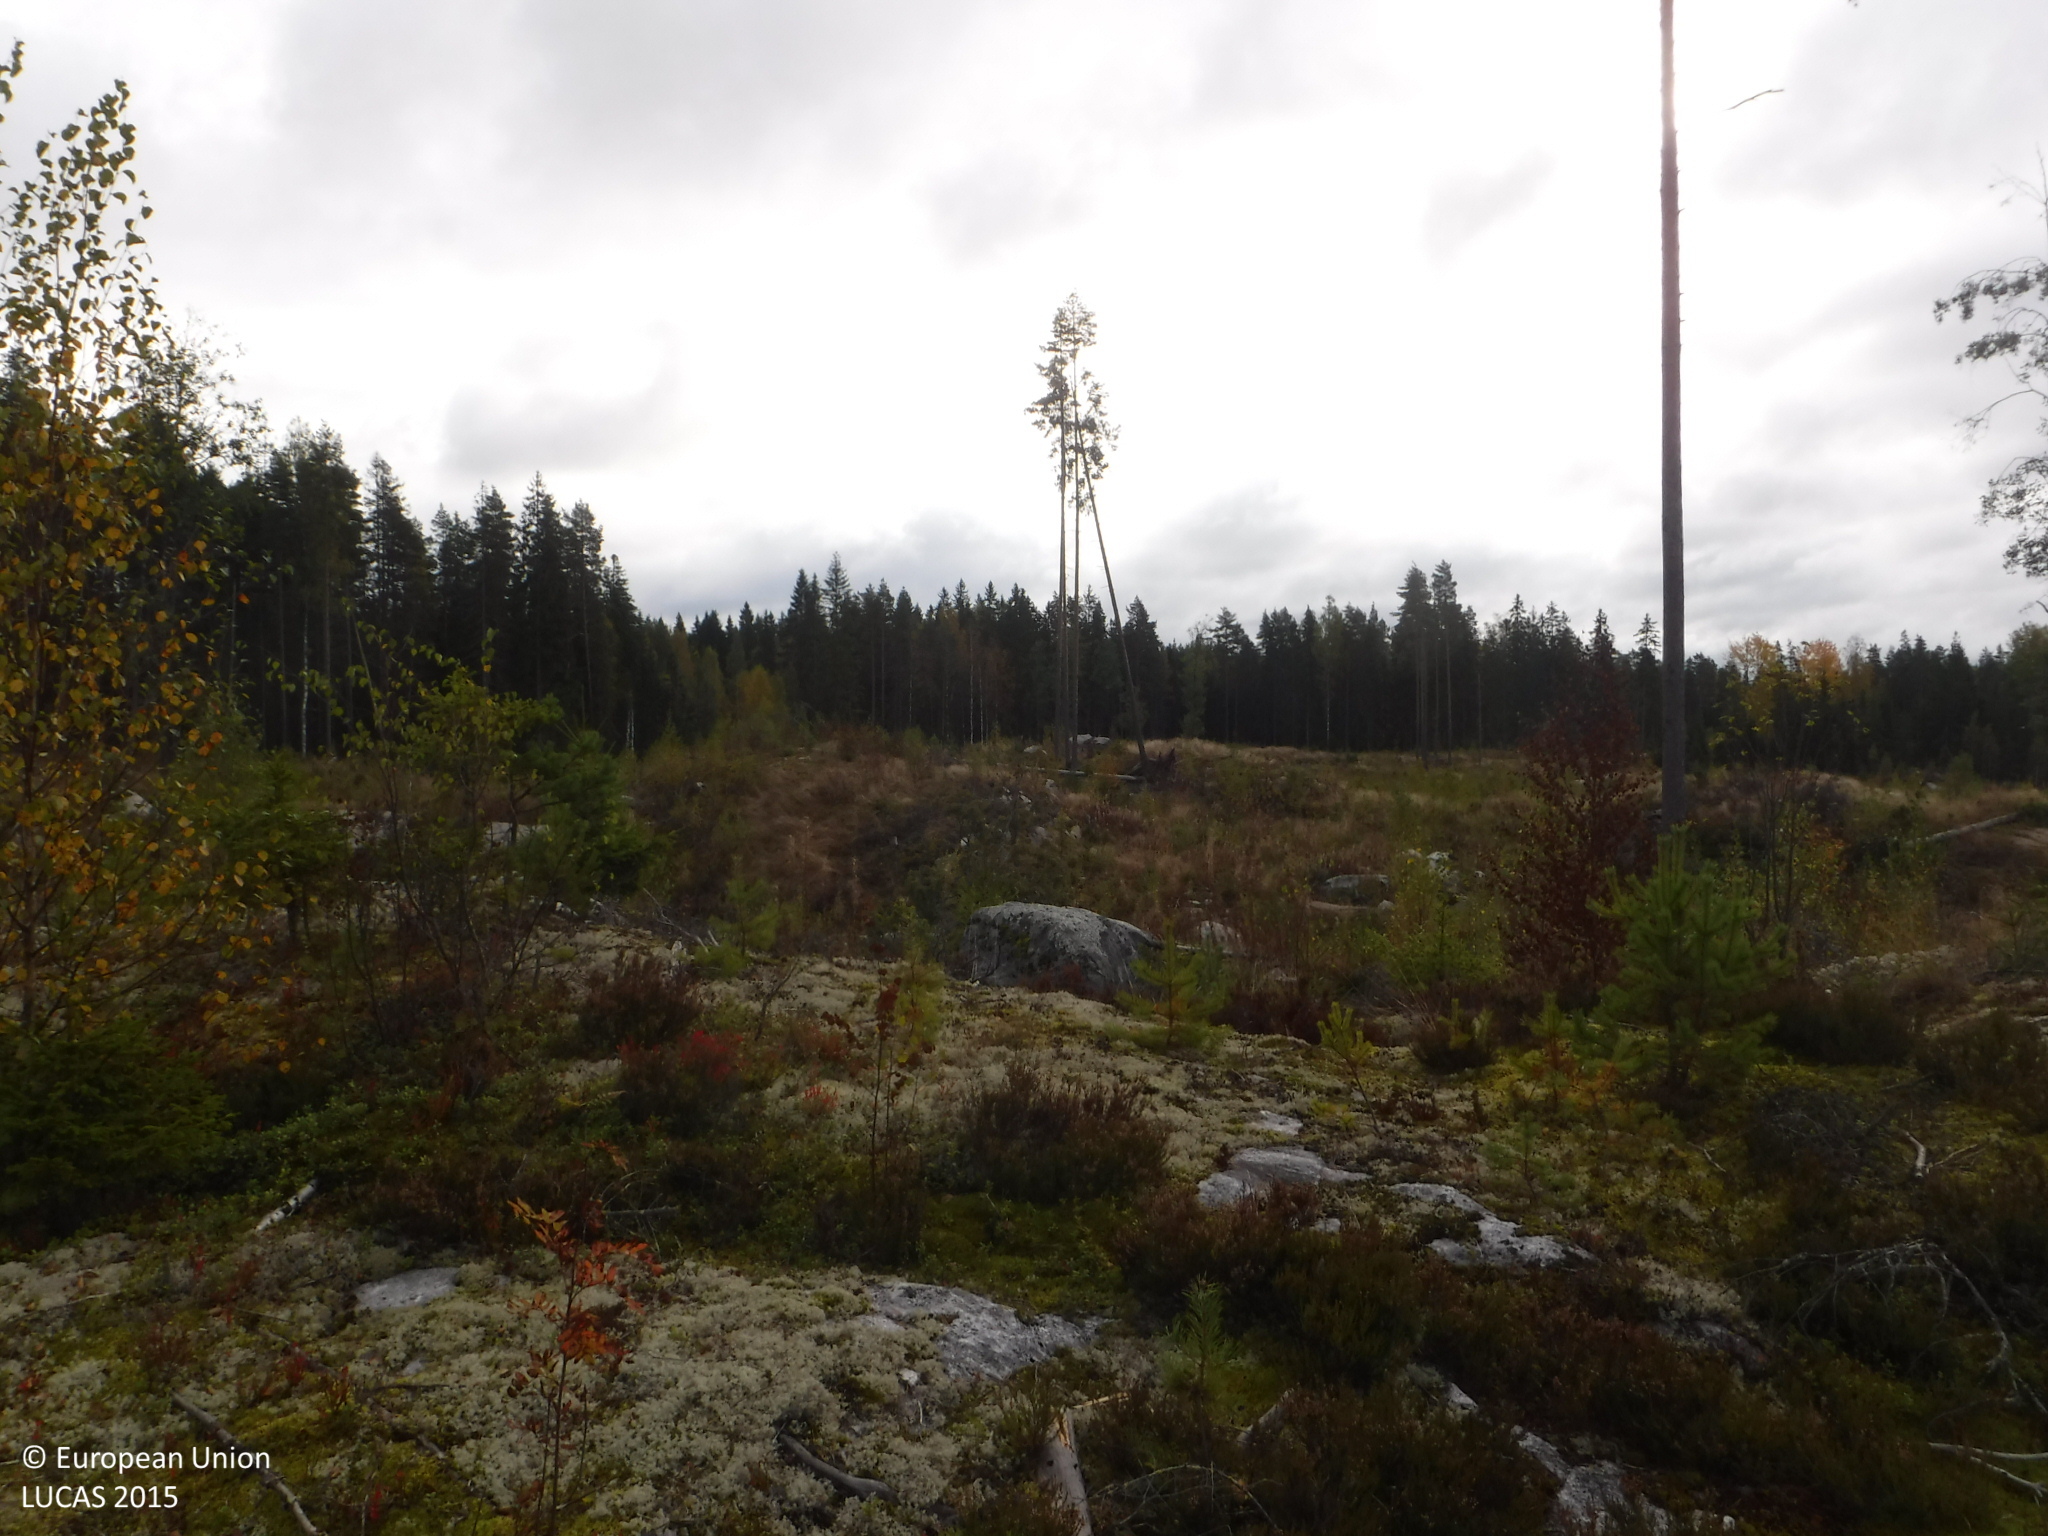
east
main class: Woodland
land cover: Other mixed woodland
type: boreal forest
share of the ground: 10 - 25 %
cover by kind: shrubs 60 %, lichens and mosses 20 %, herbaceous plants 10 %, coniferous forest trees 5 %, broadleaved forest trees 5 %
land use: Forestry
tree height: < 5 m
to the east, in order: Other mixed woodland; Broadleaved woodland; Other coniferous woodland; Ditches and canals; Other mixed woodland
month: September
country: FI
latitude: 61.5153
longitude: 23.9782
